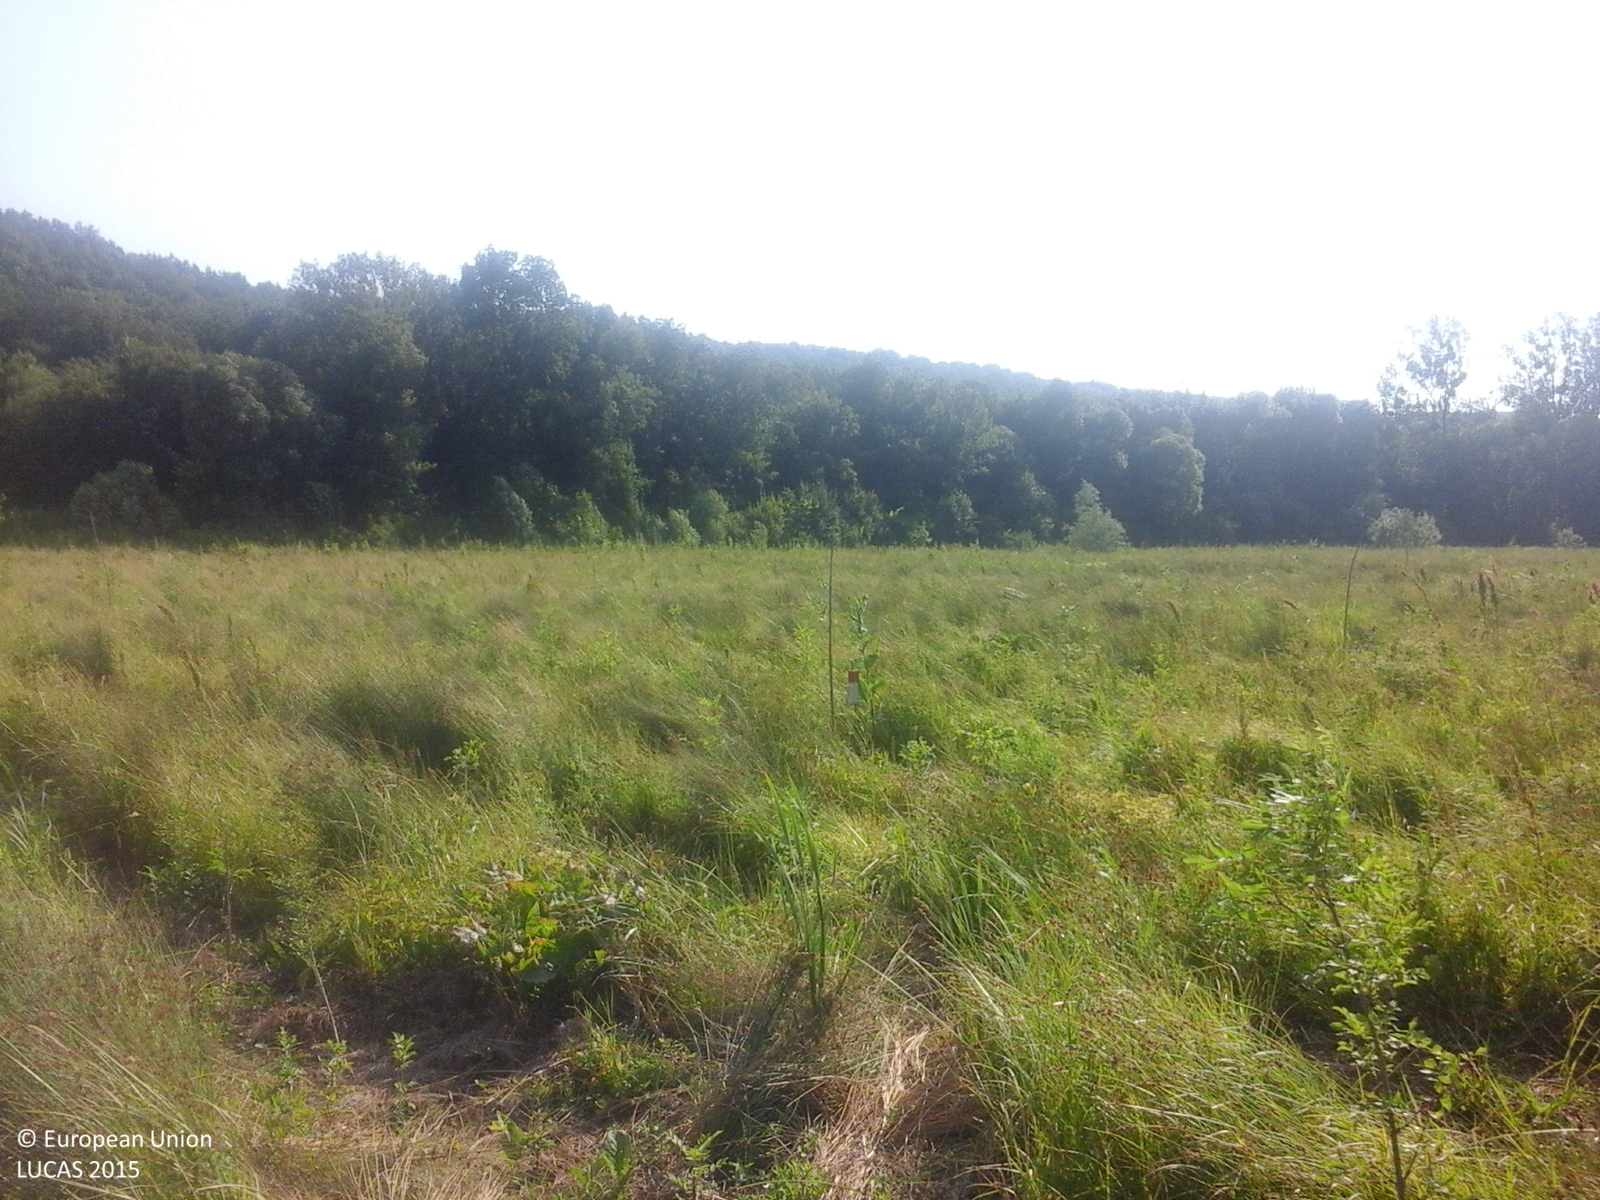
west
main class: Grassland
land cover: Grassland without tree/shrub cover
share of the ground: > 75 %
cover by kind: herbaceous plants 95 %, shrubs 5 %
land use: Agriculture (excluding fallow land and kitchen gardens)
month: June
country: RO
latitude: 46.5874
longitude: 27.7244
